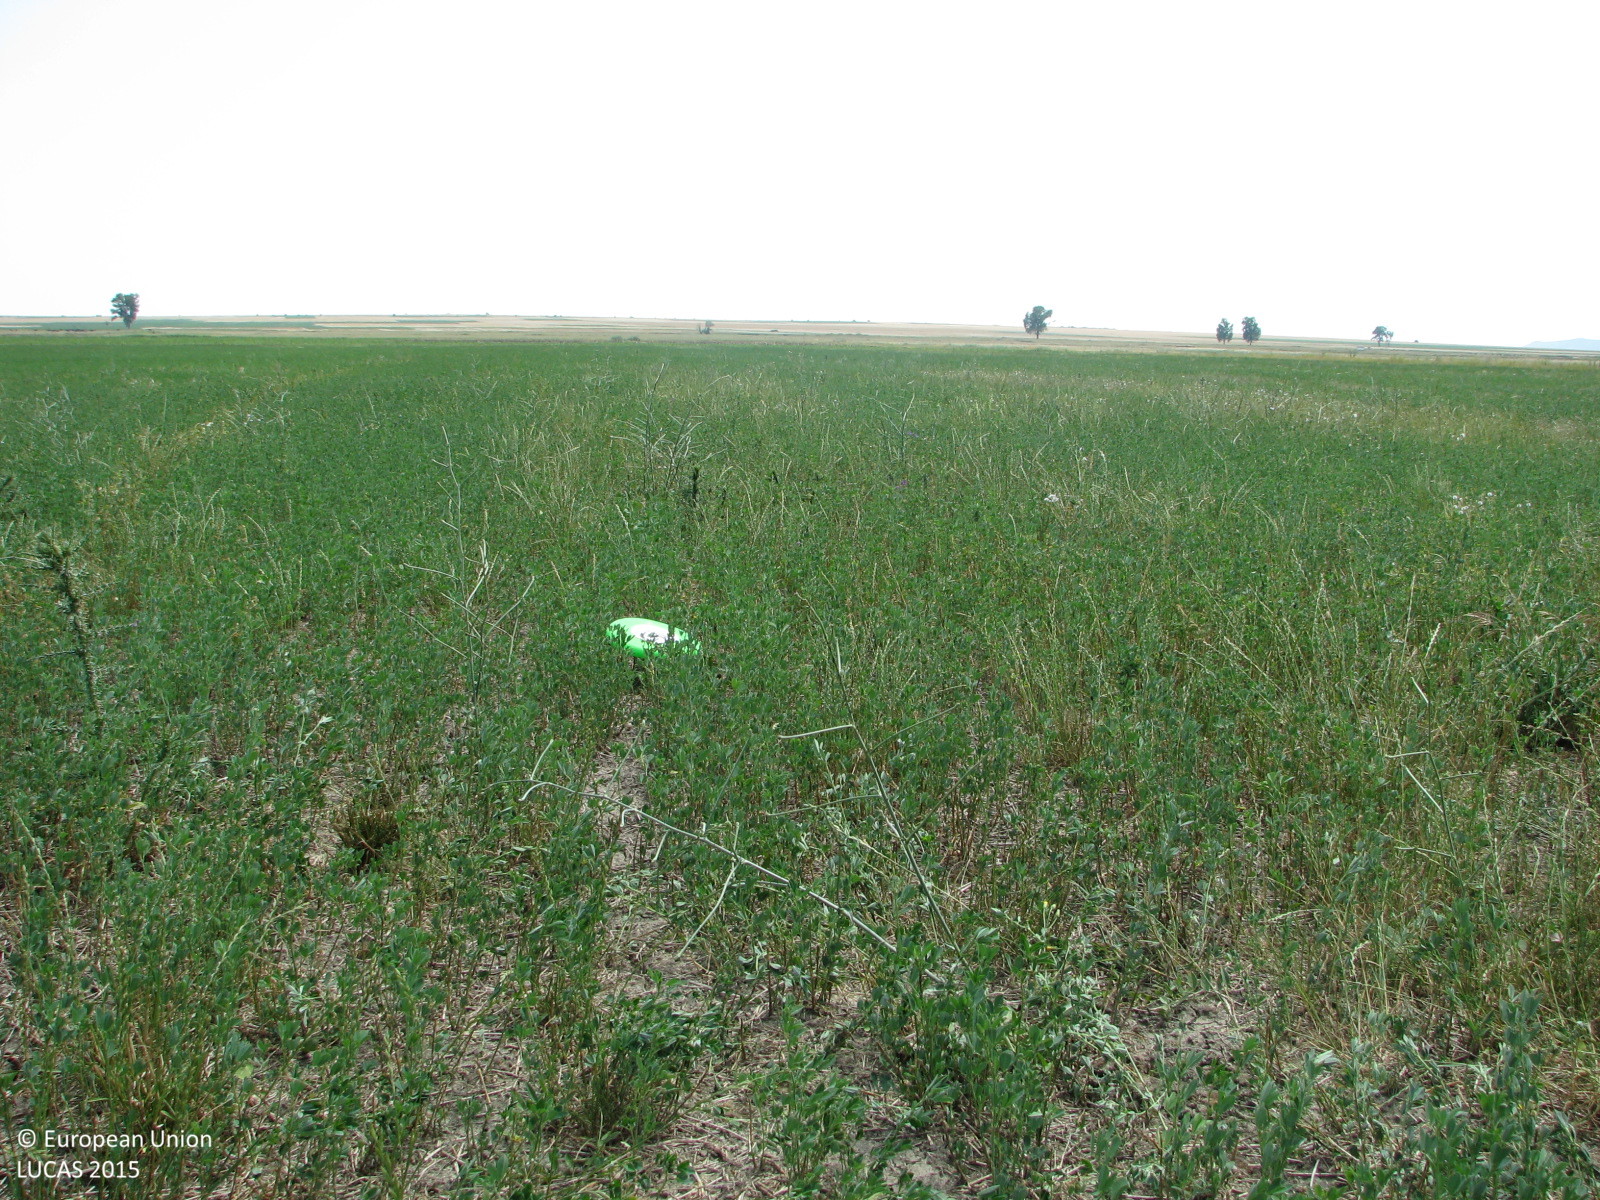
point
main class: Cropland
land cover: Lucerne
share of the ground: > 75 %
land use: Agriculture (excluding fallow land and kitchen gardens)
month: June
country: BG
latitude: 42.6254
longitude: 26.5432
